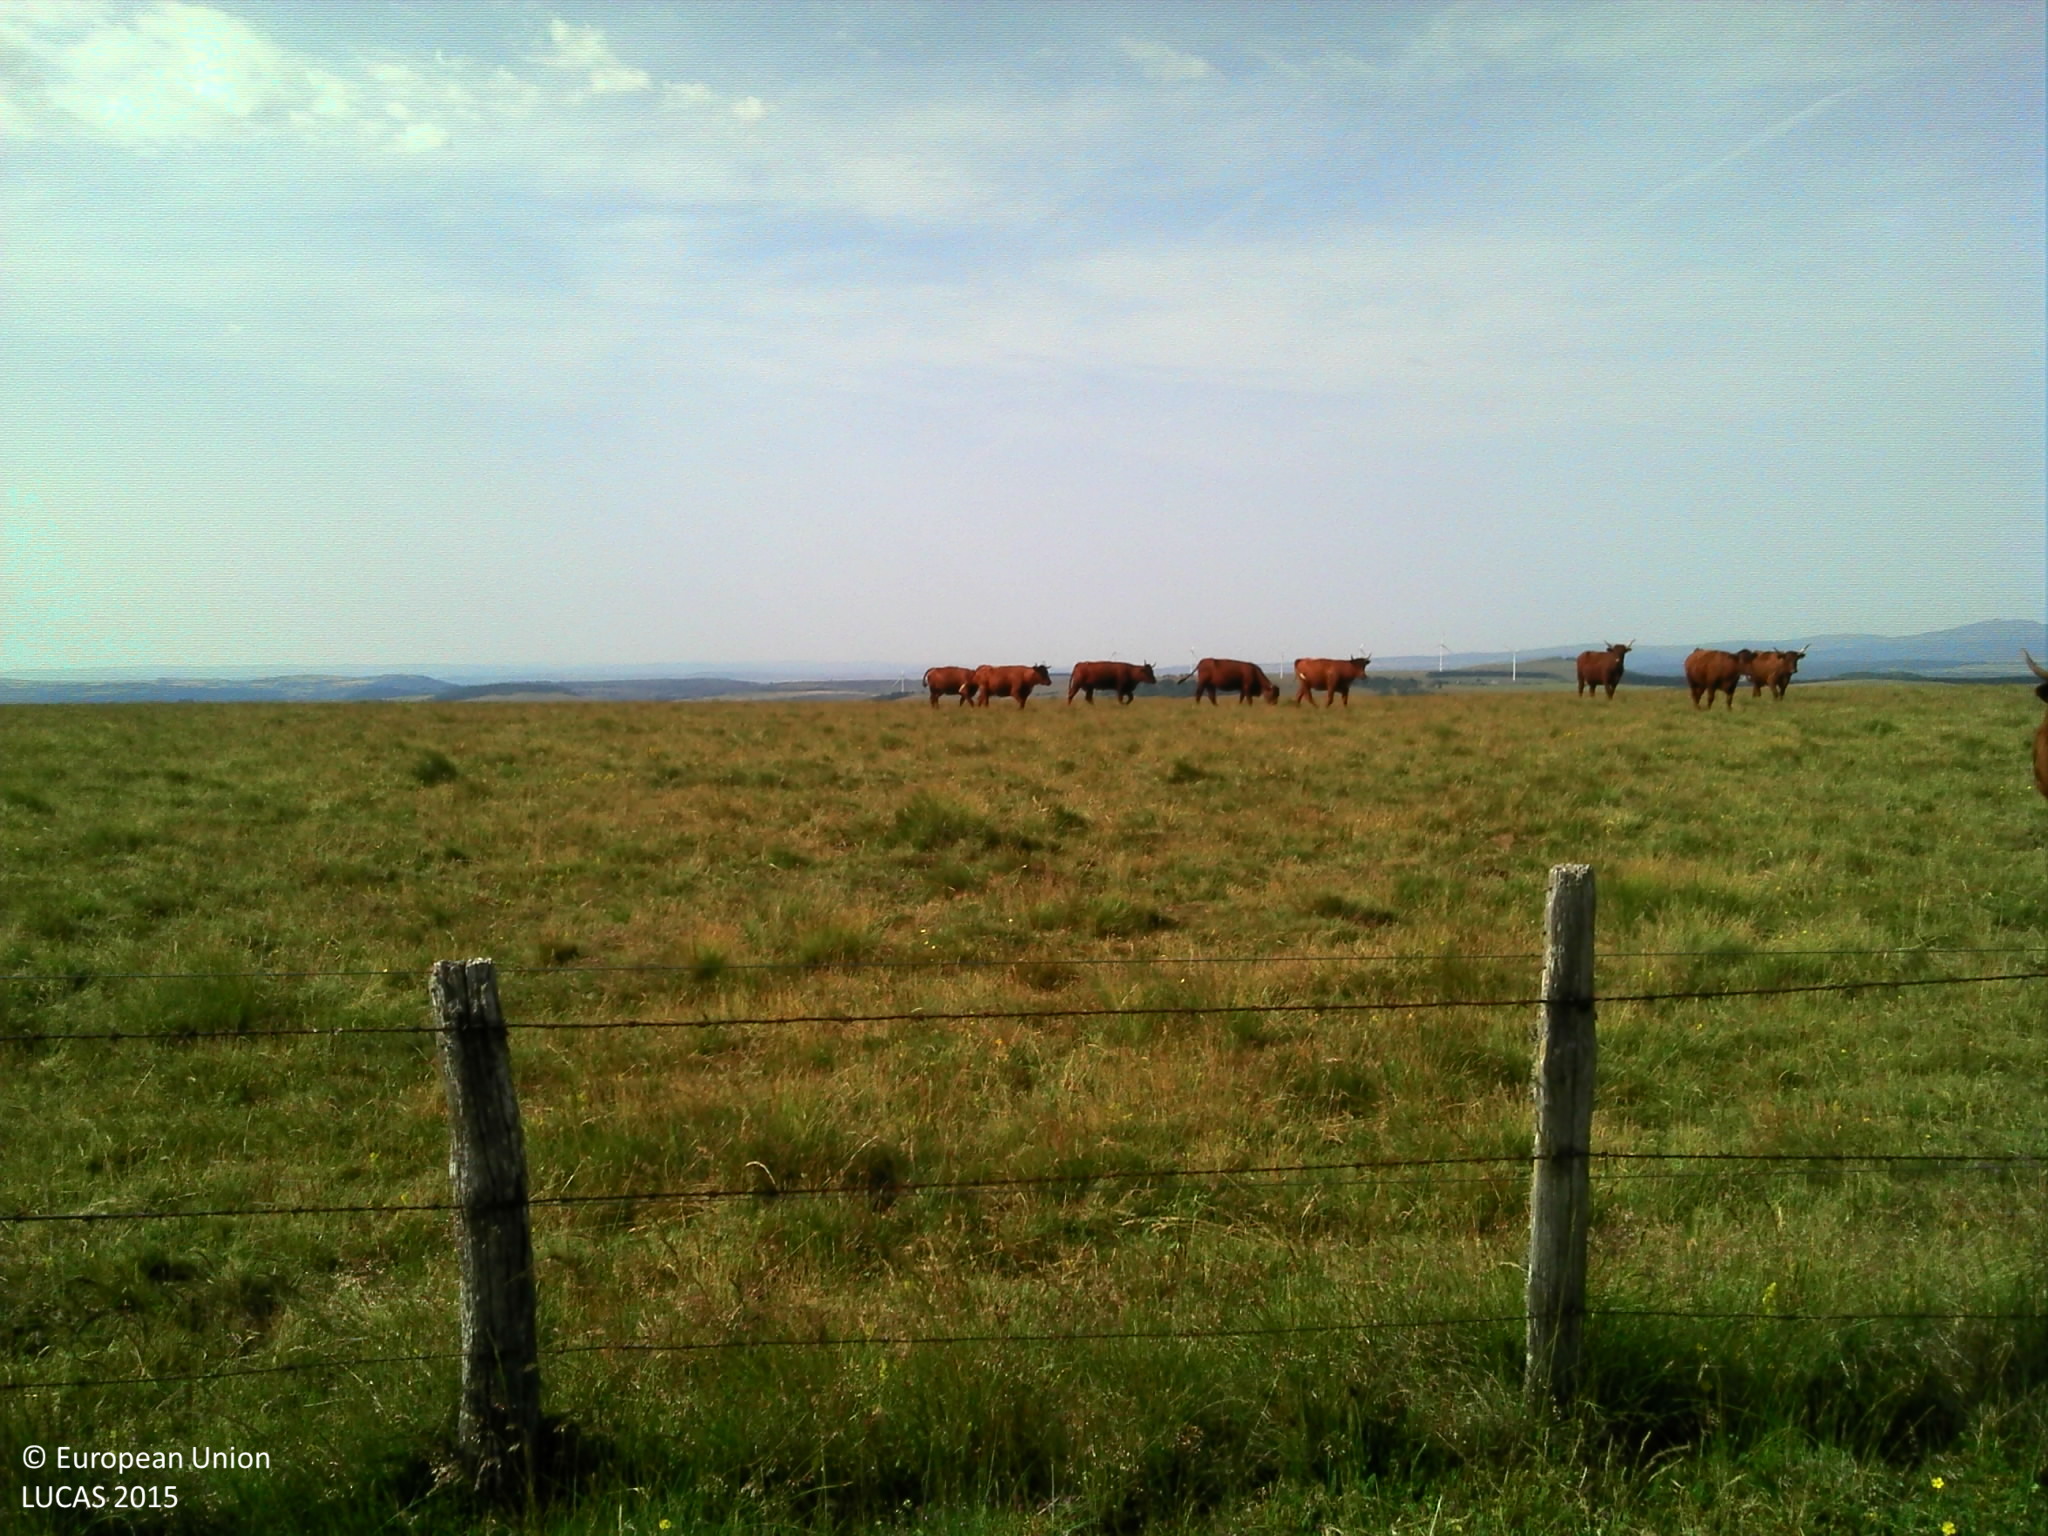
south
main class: Grassland
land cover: Grassland without tree/shrub cover
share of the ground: > 75 %
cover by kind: herbaceous plants 100 %
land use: Agriculture (excluding fallow land and kitchen gardens)
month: July
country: FR
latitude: 45.2901
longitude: 3.0011
